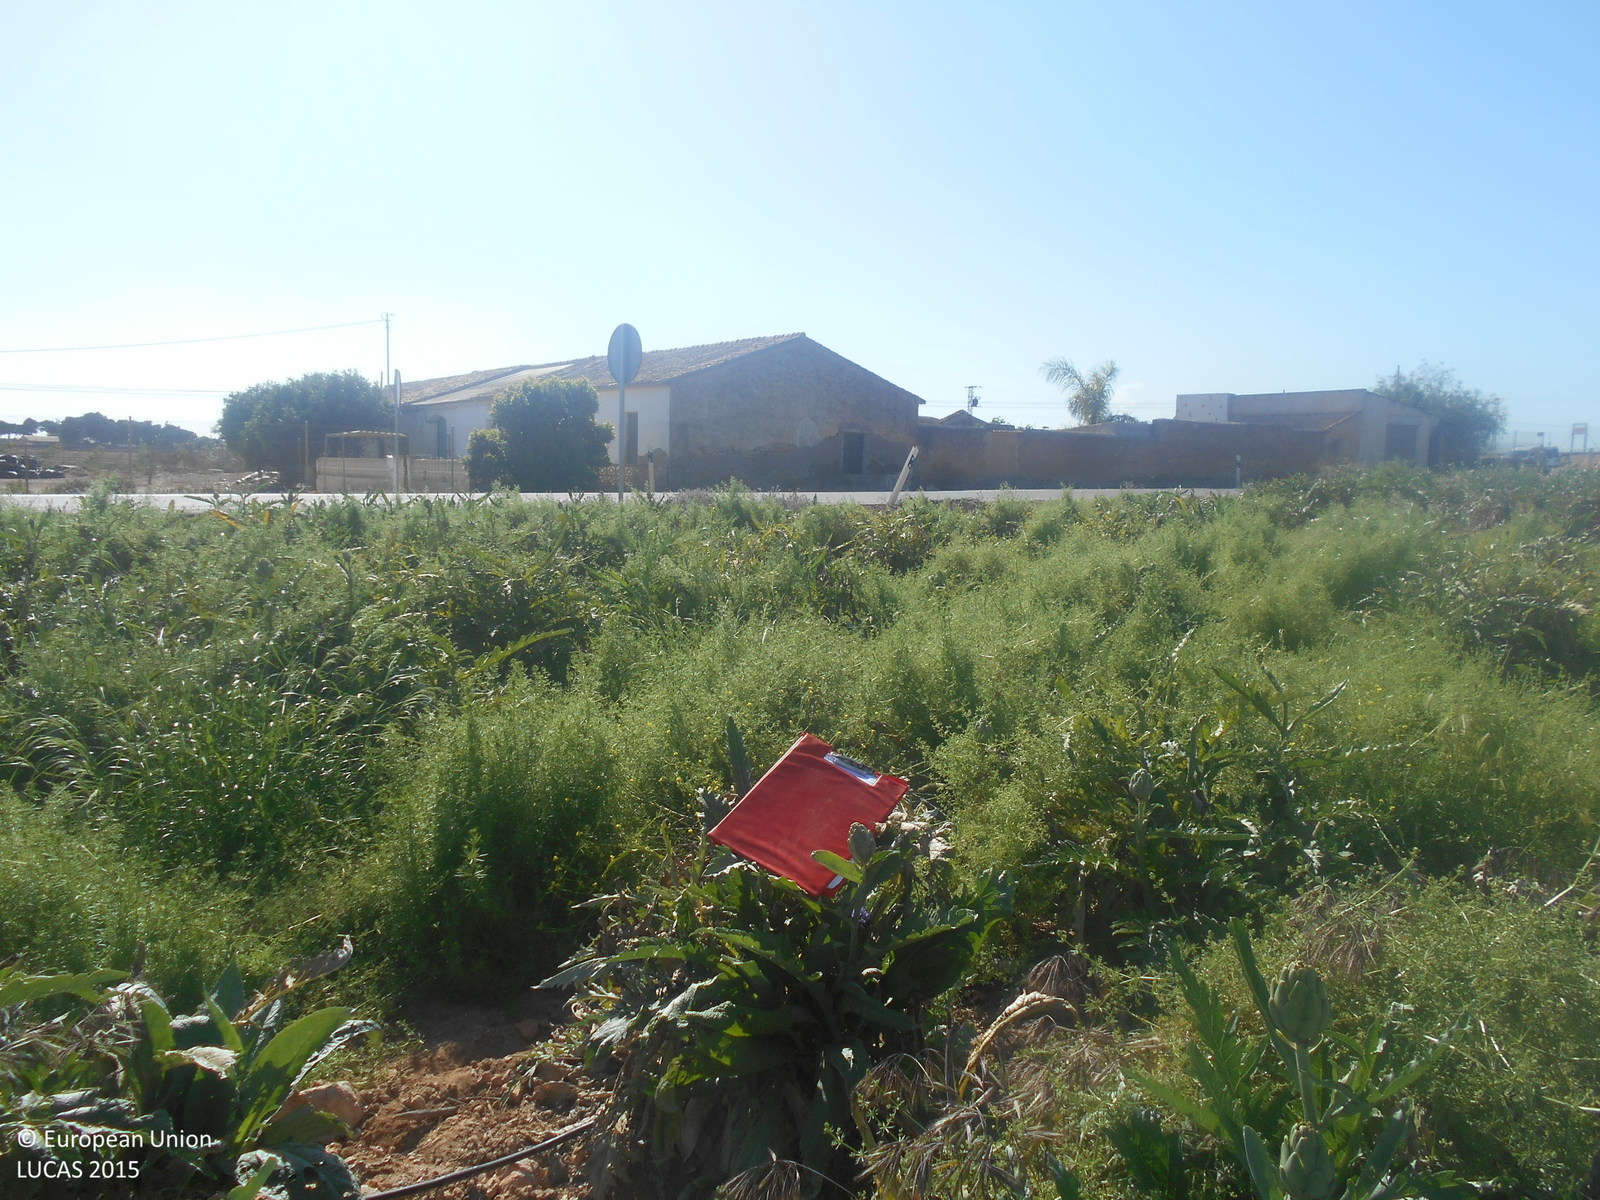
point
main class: Cropland
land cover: Other fresh vegetables
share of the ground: 25 - 50 %
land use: Agriculture (excluding fallow land and kitchen gardens)
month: May
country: ES
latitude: 37.8269
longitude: -0.9447
